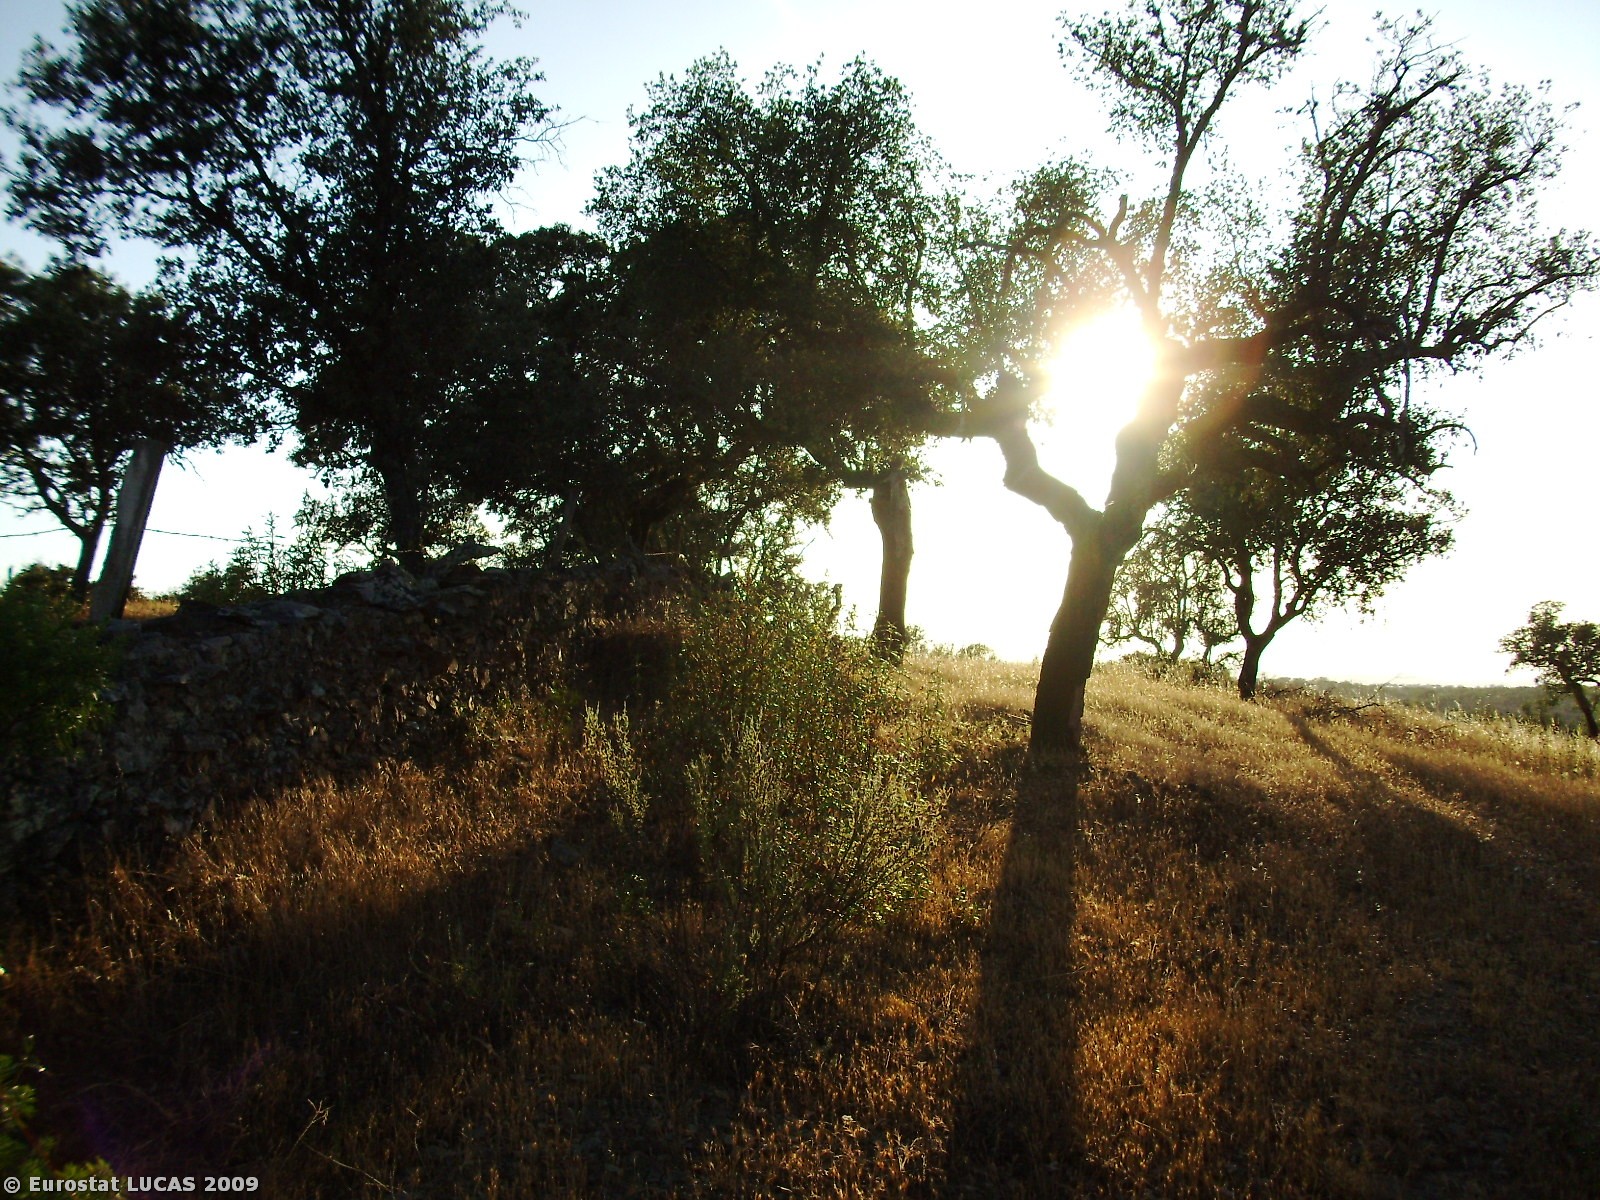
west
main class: Woodland
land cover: Broadleaved woodland
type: broadleaved evergreen forest
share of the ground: 10 - 25 %
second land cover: Spontaneously vegetated surfaces
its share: 50 - 75 %
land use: Forestry
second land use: Fallow land
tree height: > 5 m
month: April
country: PT
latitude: 39.5415
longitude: -7.5371
